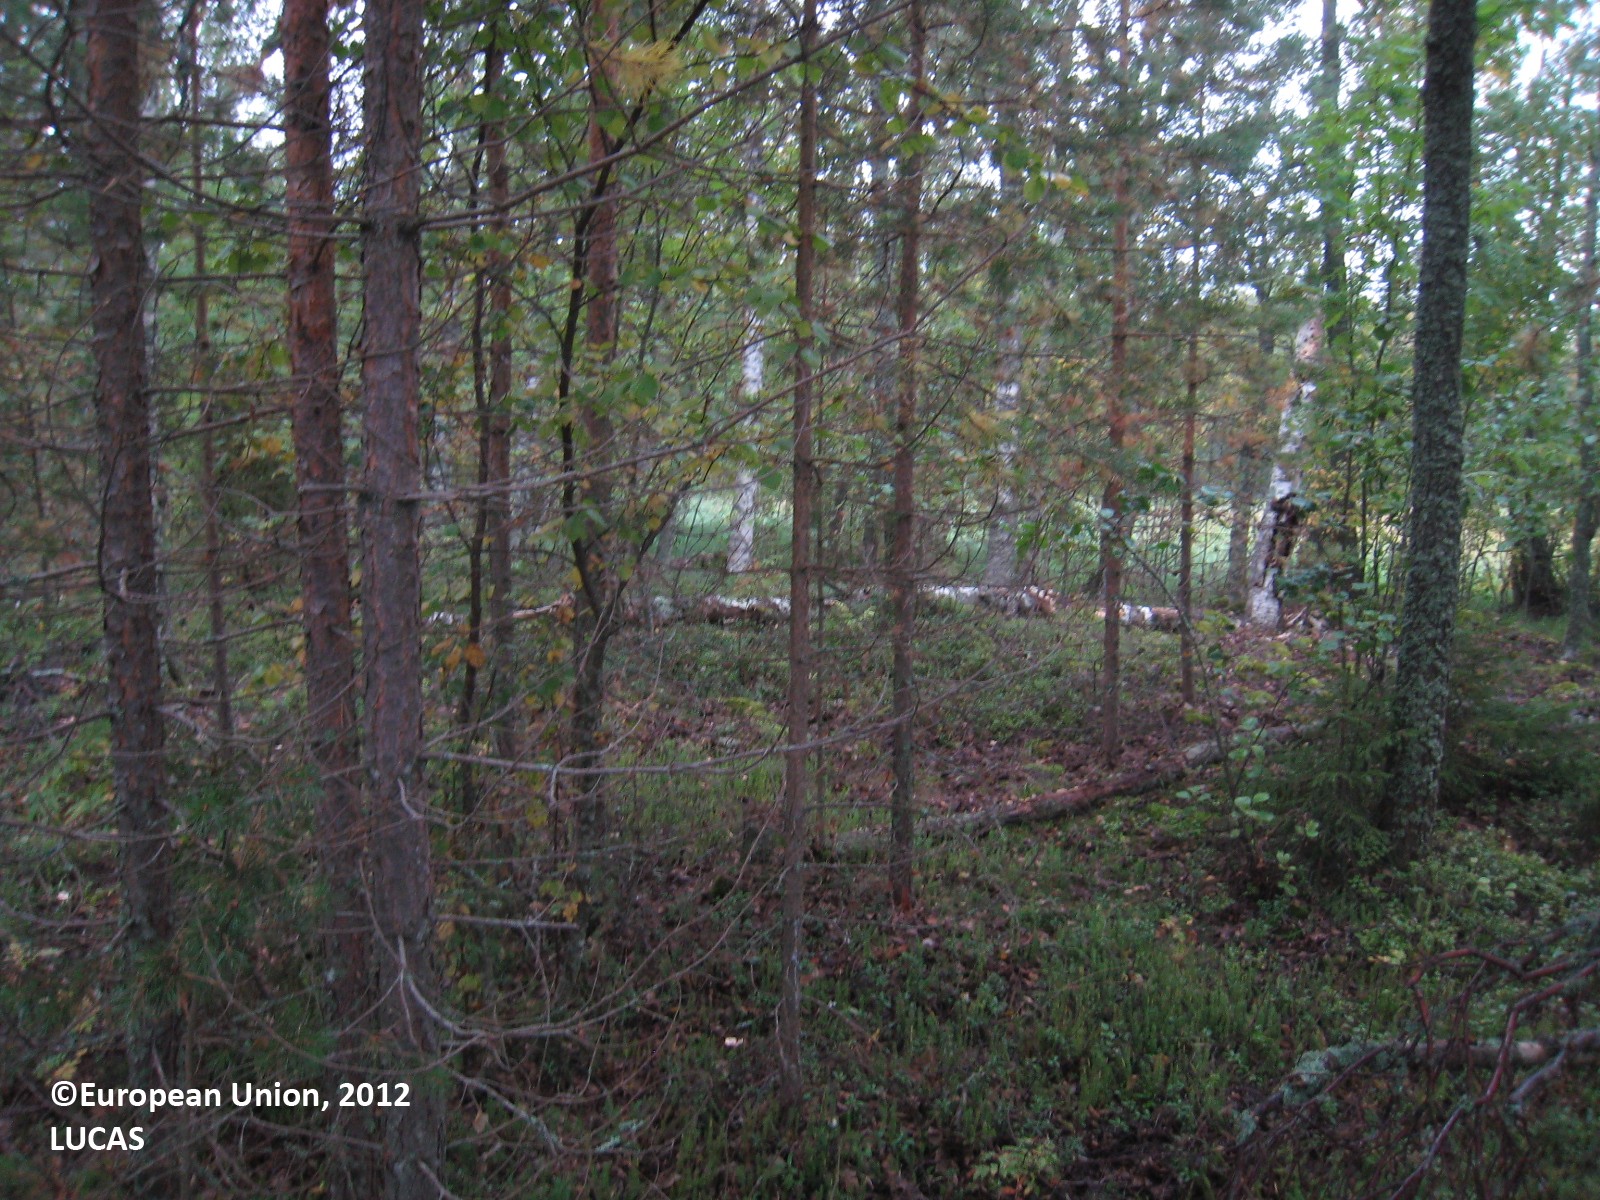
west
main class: Woodland
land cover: Pine dominated mixed woodland
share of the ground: > 75 %
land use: Semi-natural and natural areas not in use
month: September
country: FI
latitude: 61.6330
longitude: 26.0387
